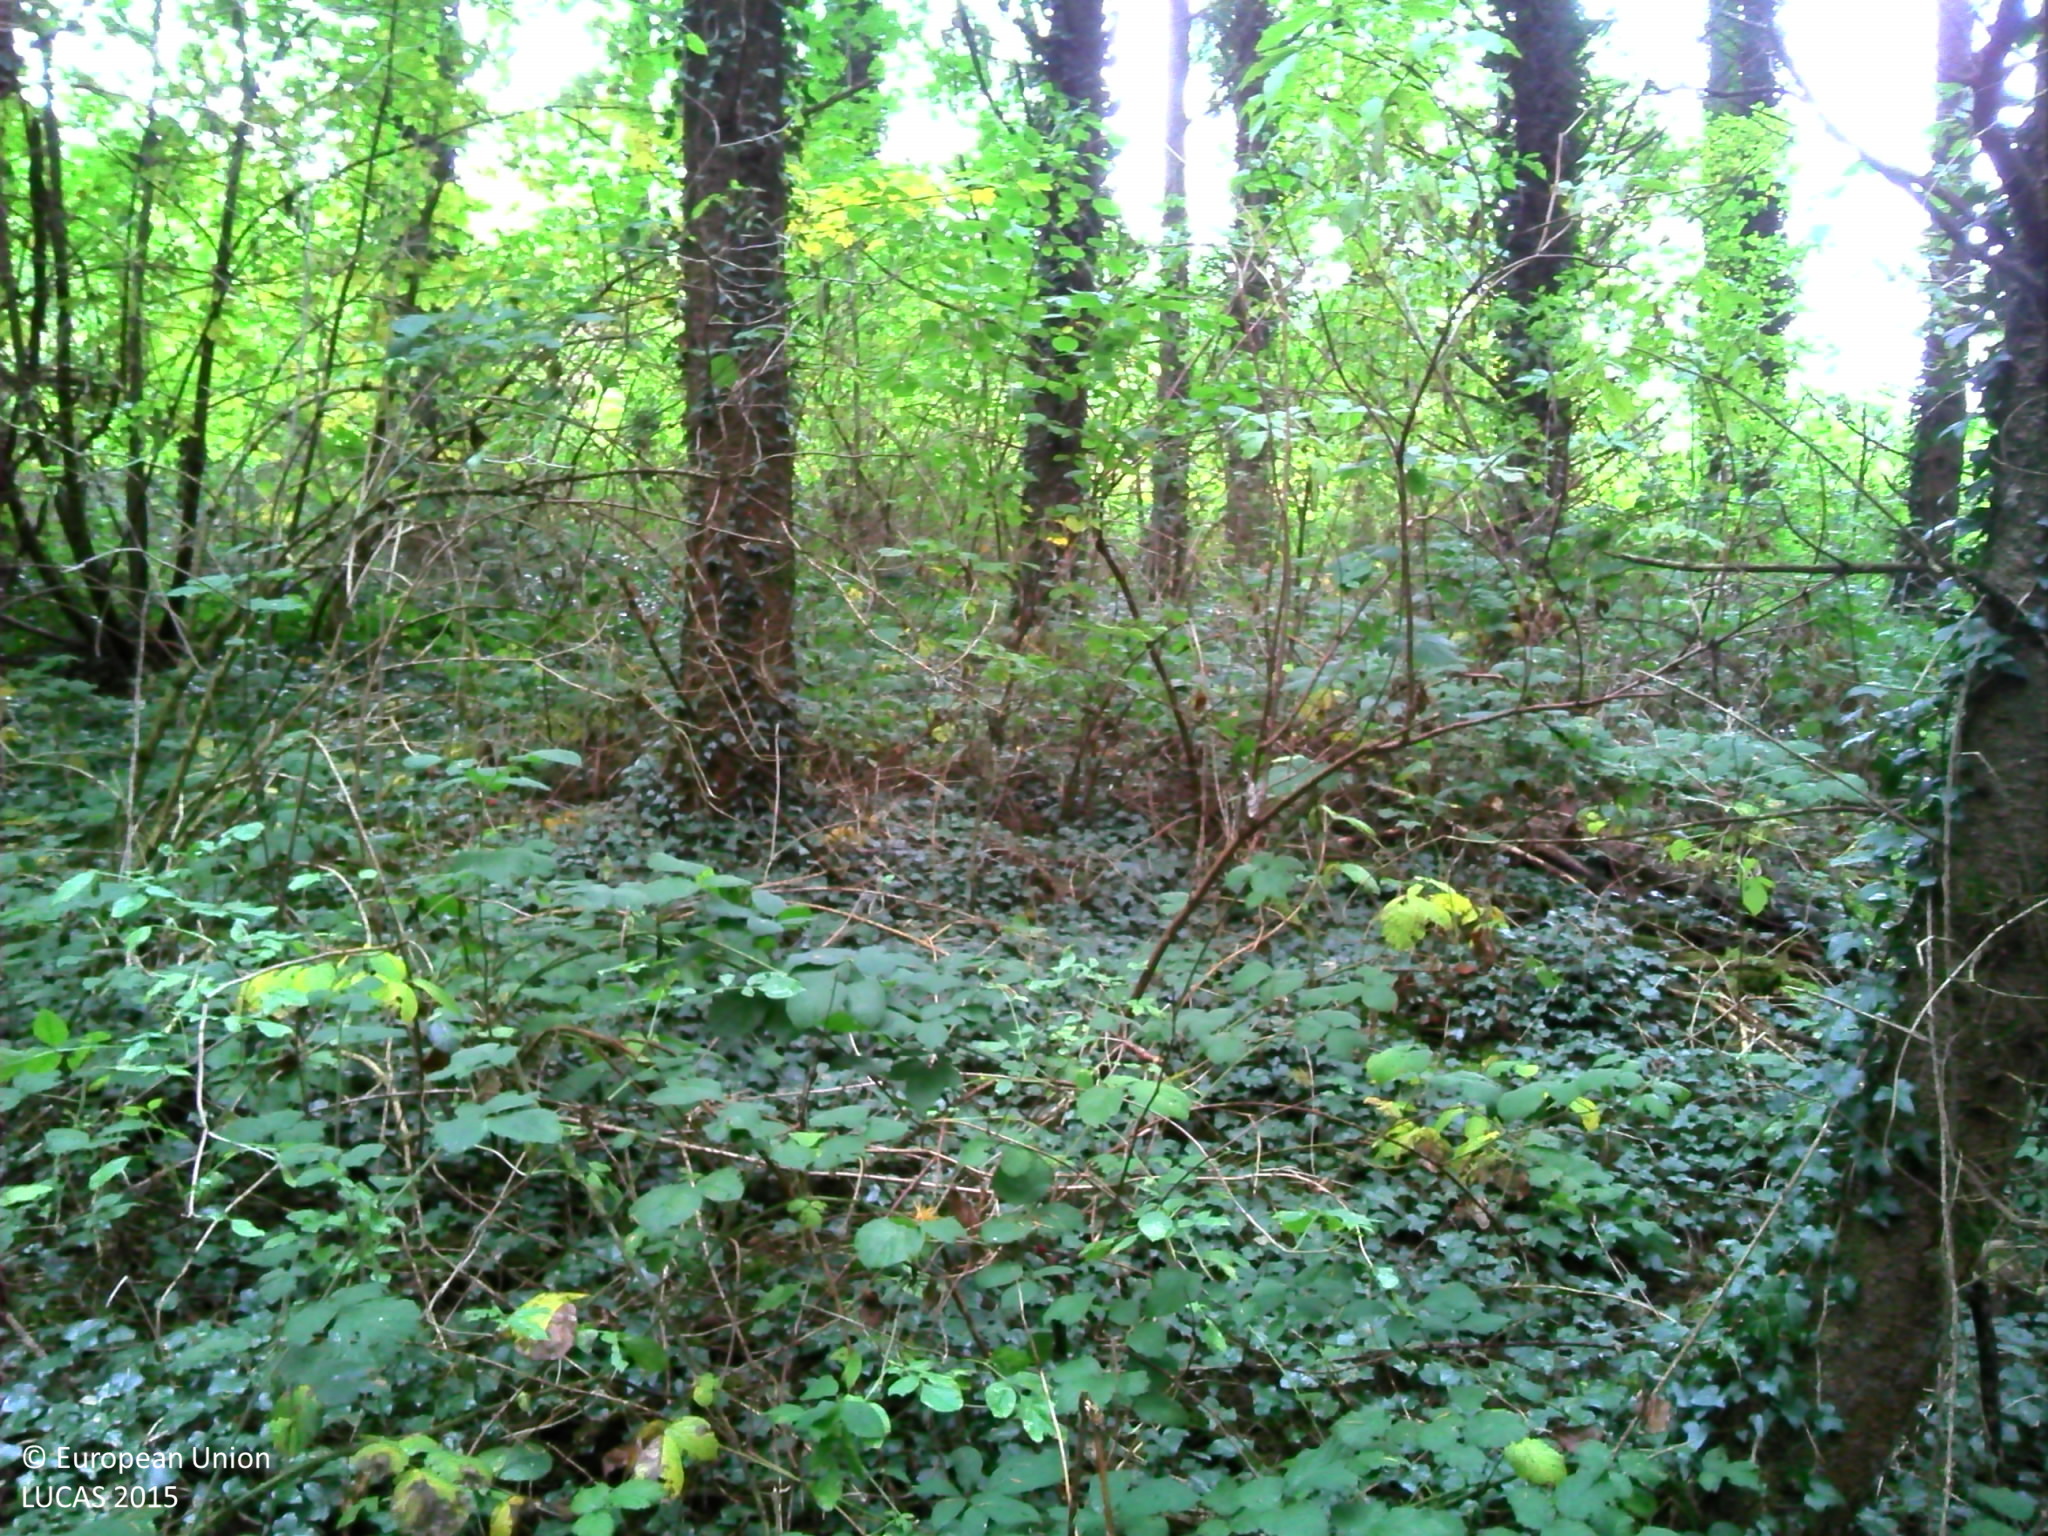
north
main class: Woodland
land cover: Other coniferous woodland
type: exotic forest
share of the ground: > 75 %
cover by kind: coniferous forest trees 80 %, herbaceous plants 15 %, broadleaved forest trees 5 %
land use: Forestry
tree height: > 5 m
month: October
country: FR
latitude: 45.9627
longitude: 2.7848
